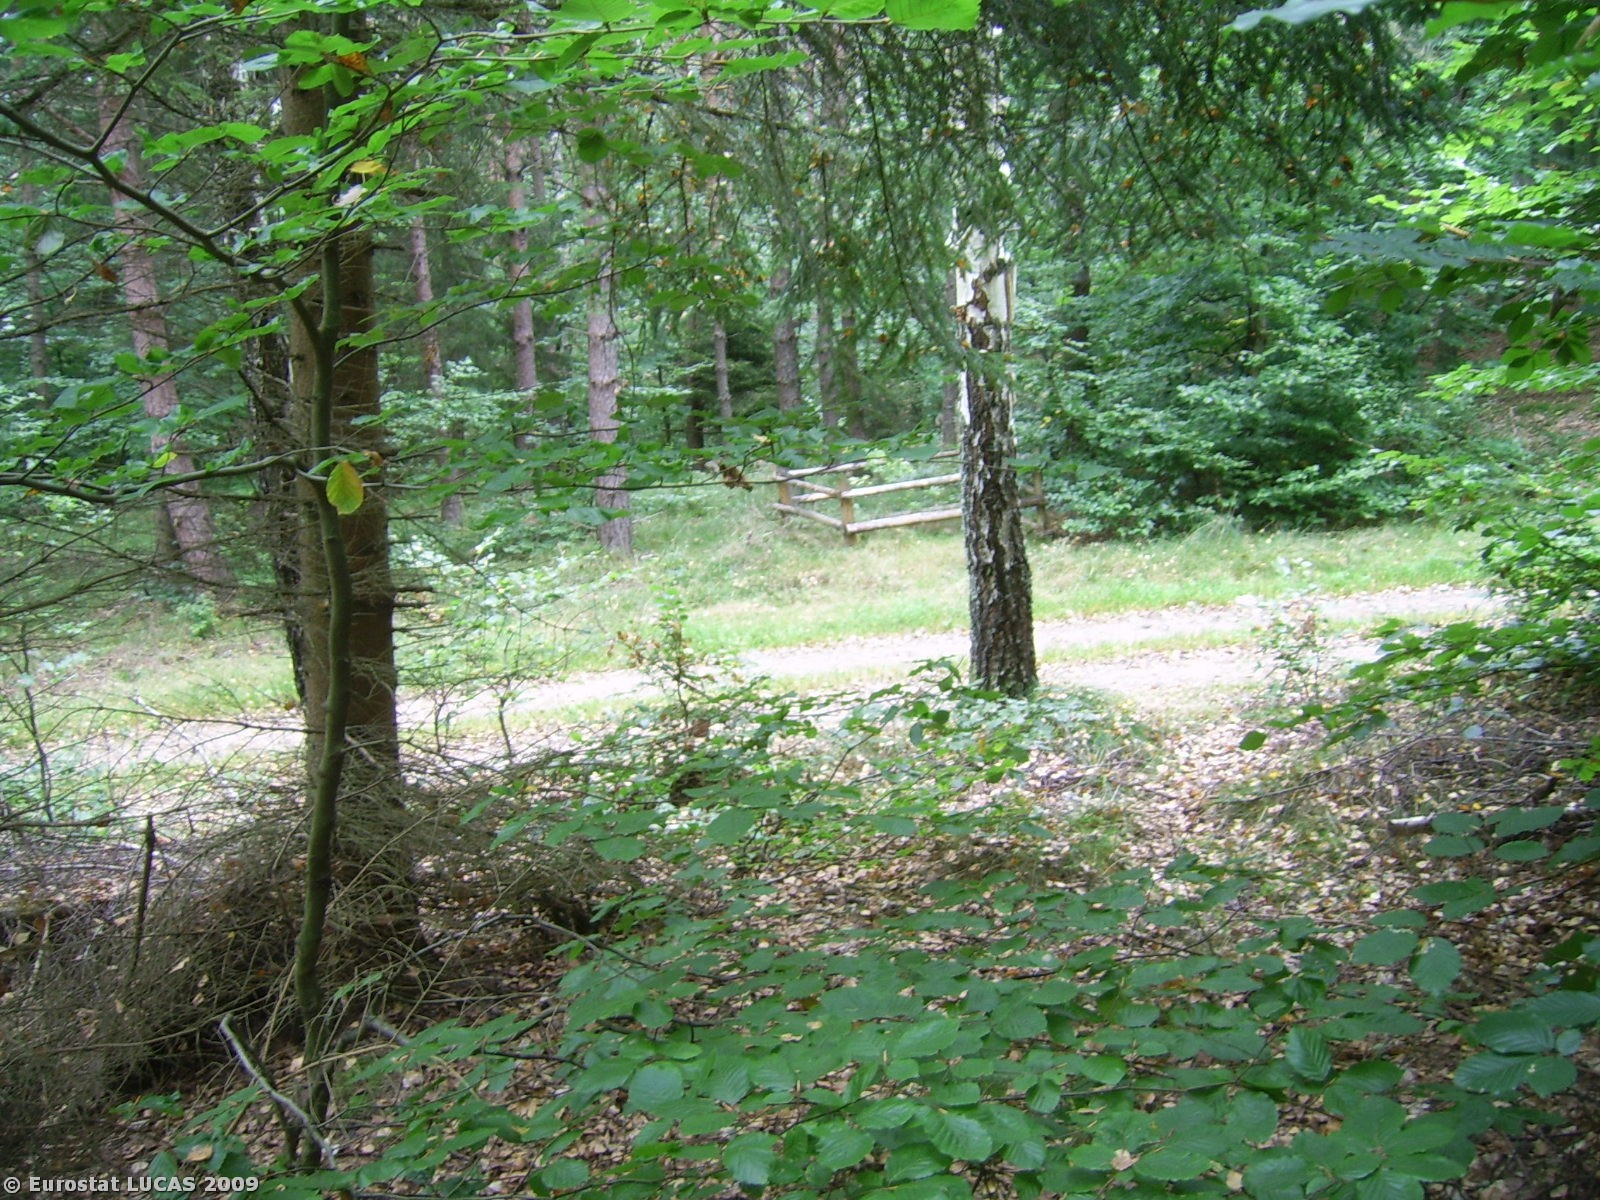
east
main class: Woodland
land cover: Mixed woodland
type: hemiboreal forest and nemoral coniferous forest and mixed broadleaved-coniferous forest
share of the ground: 50 - 75 %
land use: Forestry
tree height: > 5 m
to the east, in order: Mixed woodland; Tracks; Mixed woodland; Coniferous woodland; Tracks; Mixed woodland
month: September
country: PL
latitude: 54.1513
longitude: 16.4212
